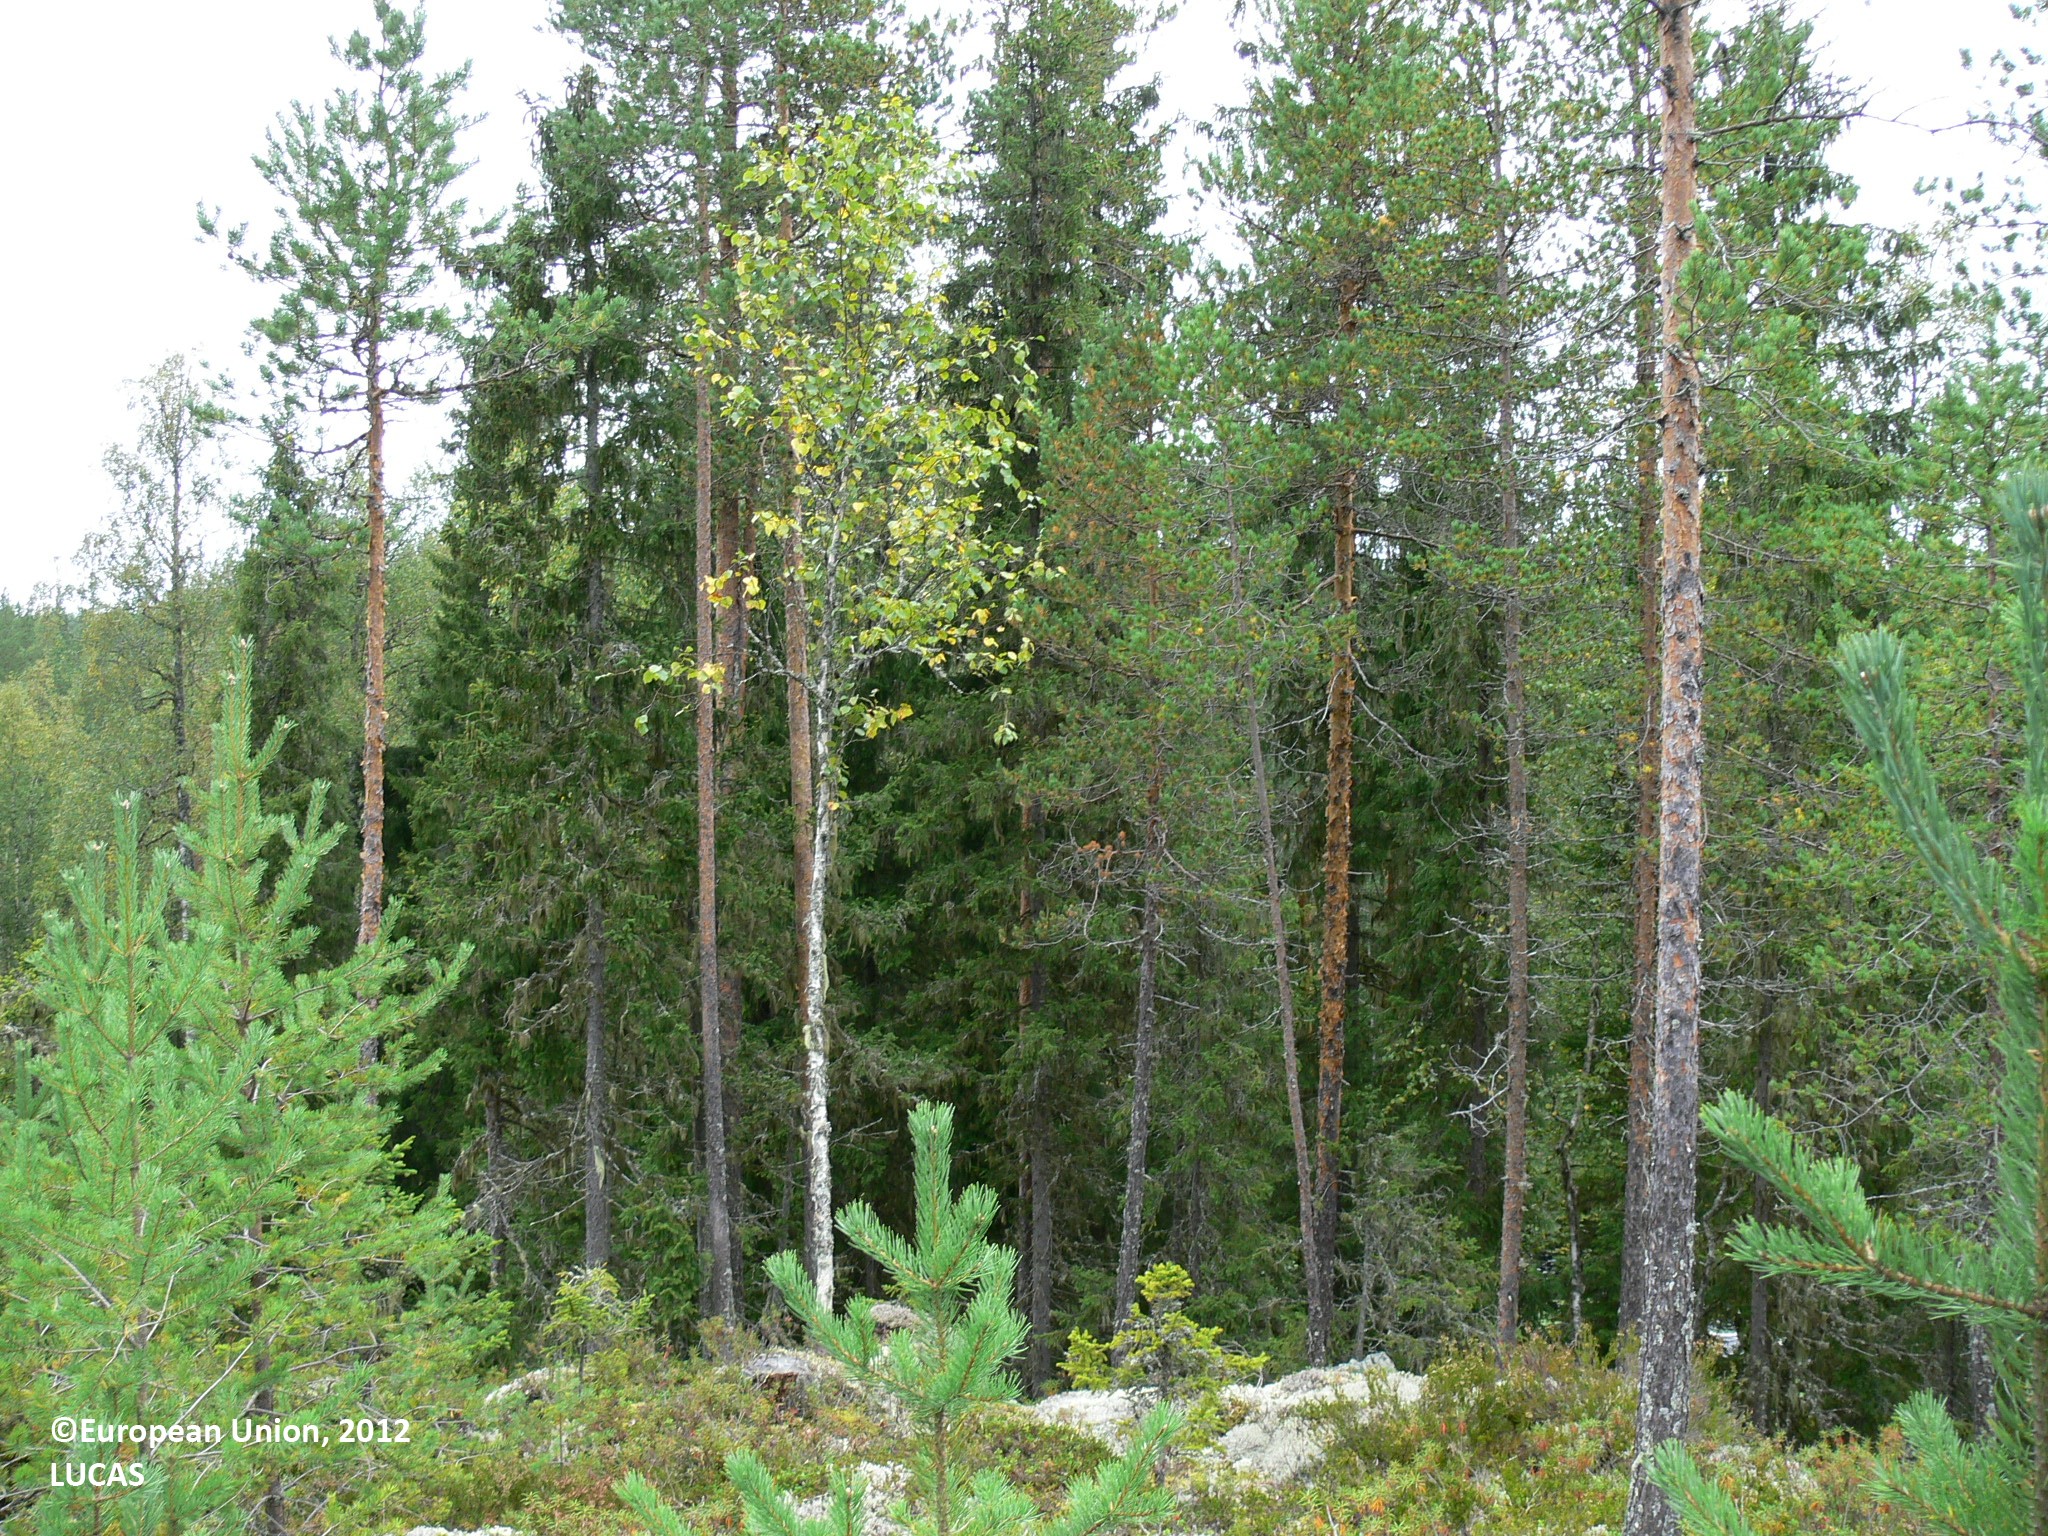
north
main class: Woodland
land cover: Pine dominated mixed woodland
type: boreal forest
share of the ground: 25 - 50 %
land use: Forestry
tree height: < 5 m
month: August
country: FI
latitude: 63.1712
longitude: 30.1795
